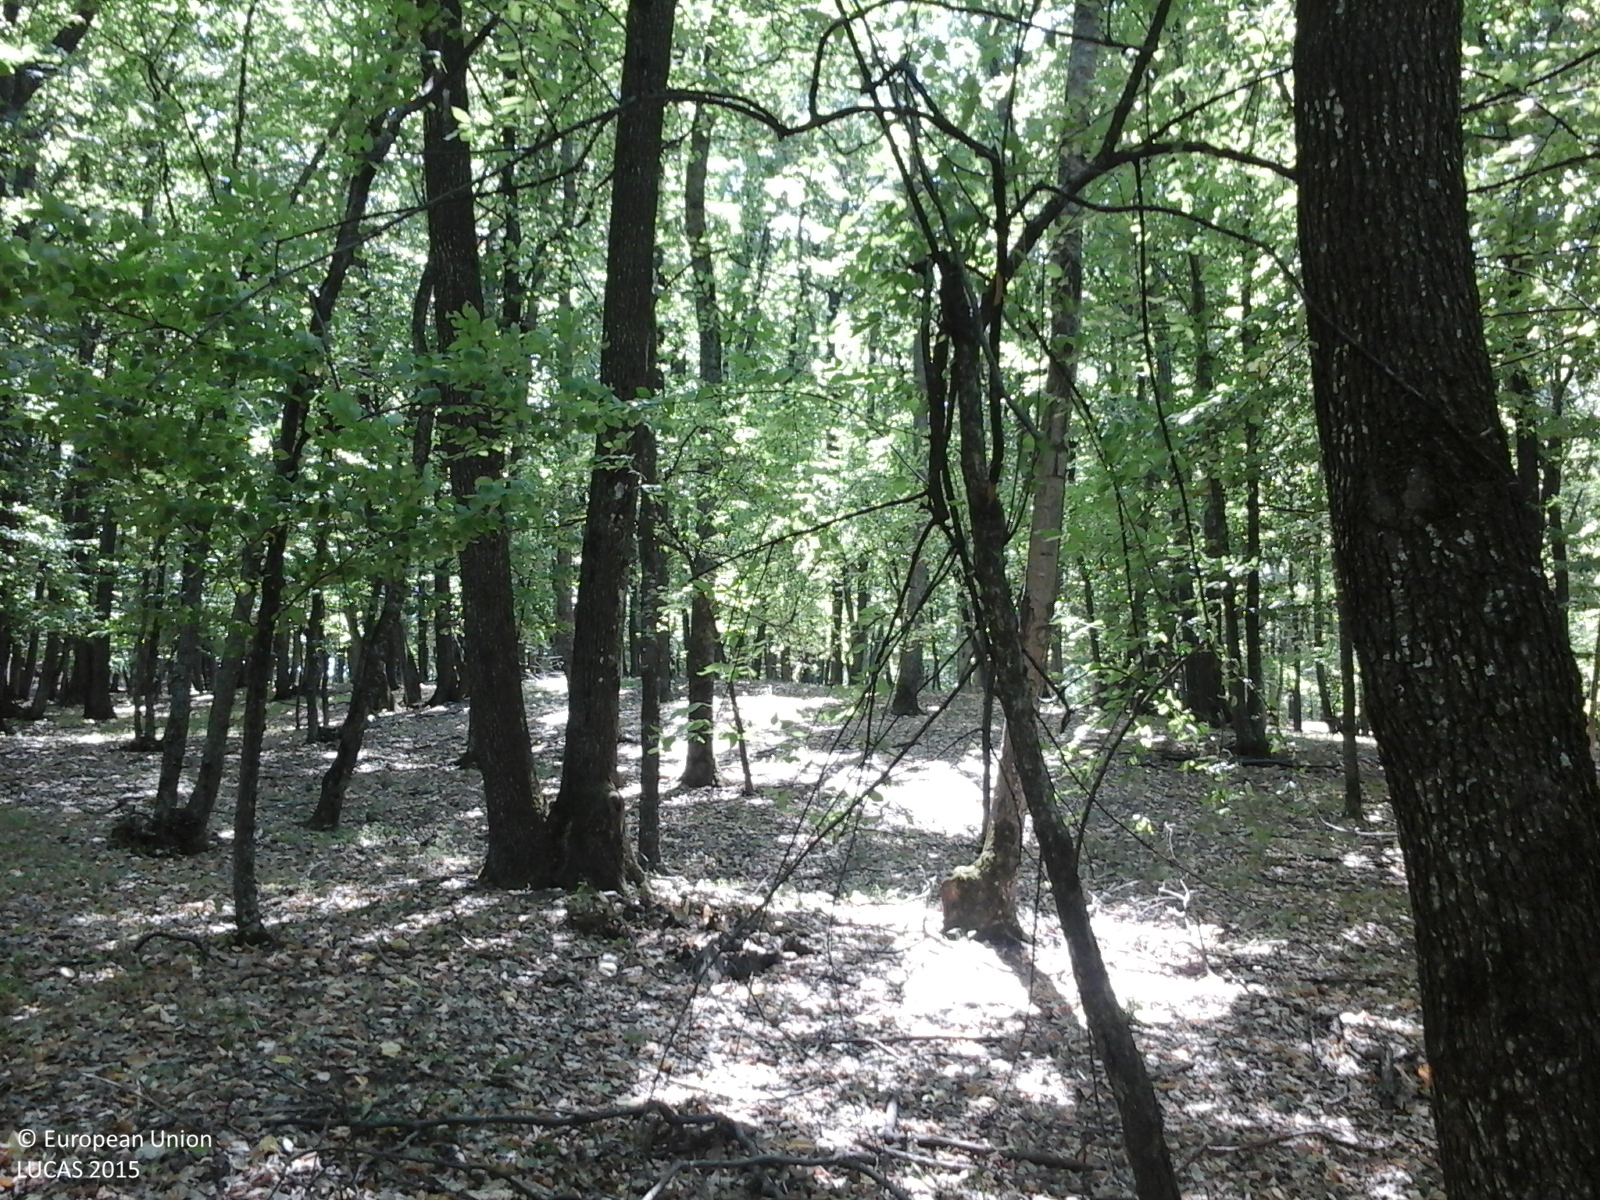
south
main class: Woodland
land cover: Broadleaved woodland
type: beech forest
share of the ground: > 75 %
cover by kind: broadleaved forest trees 100 %
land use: Forestry
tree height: > 5 m
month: July
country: RO
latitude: 46.2802
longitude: 27.2454
